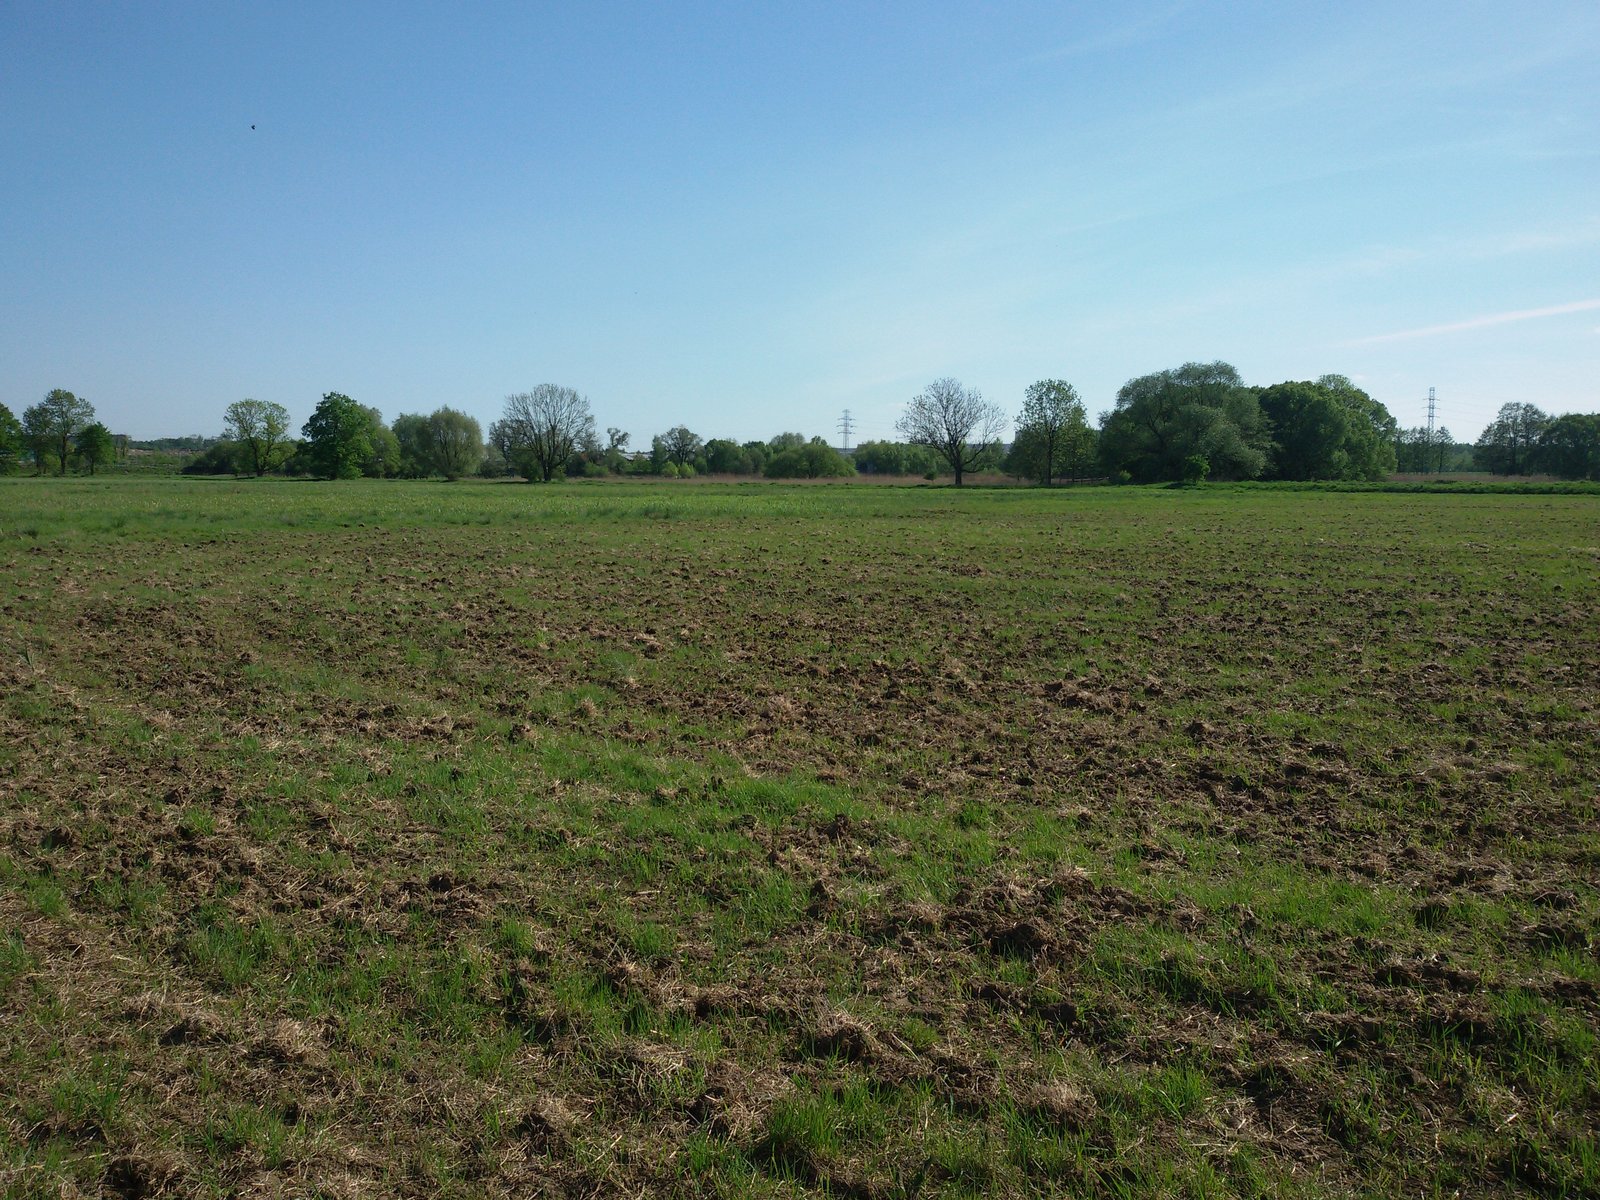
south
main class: Cropland
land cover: Temporary grasslands
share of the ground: > 75 %
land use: Agriculture (excluding fallow land and kitchen gardens)
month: May
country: PL
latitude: 50.3267
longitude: 18.6308
